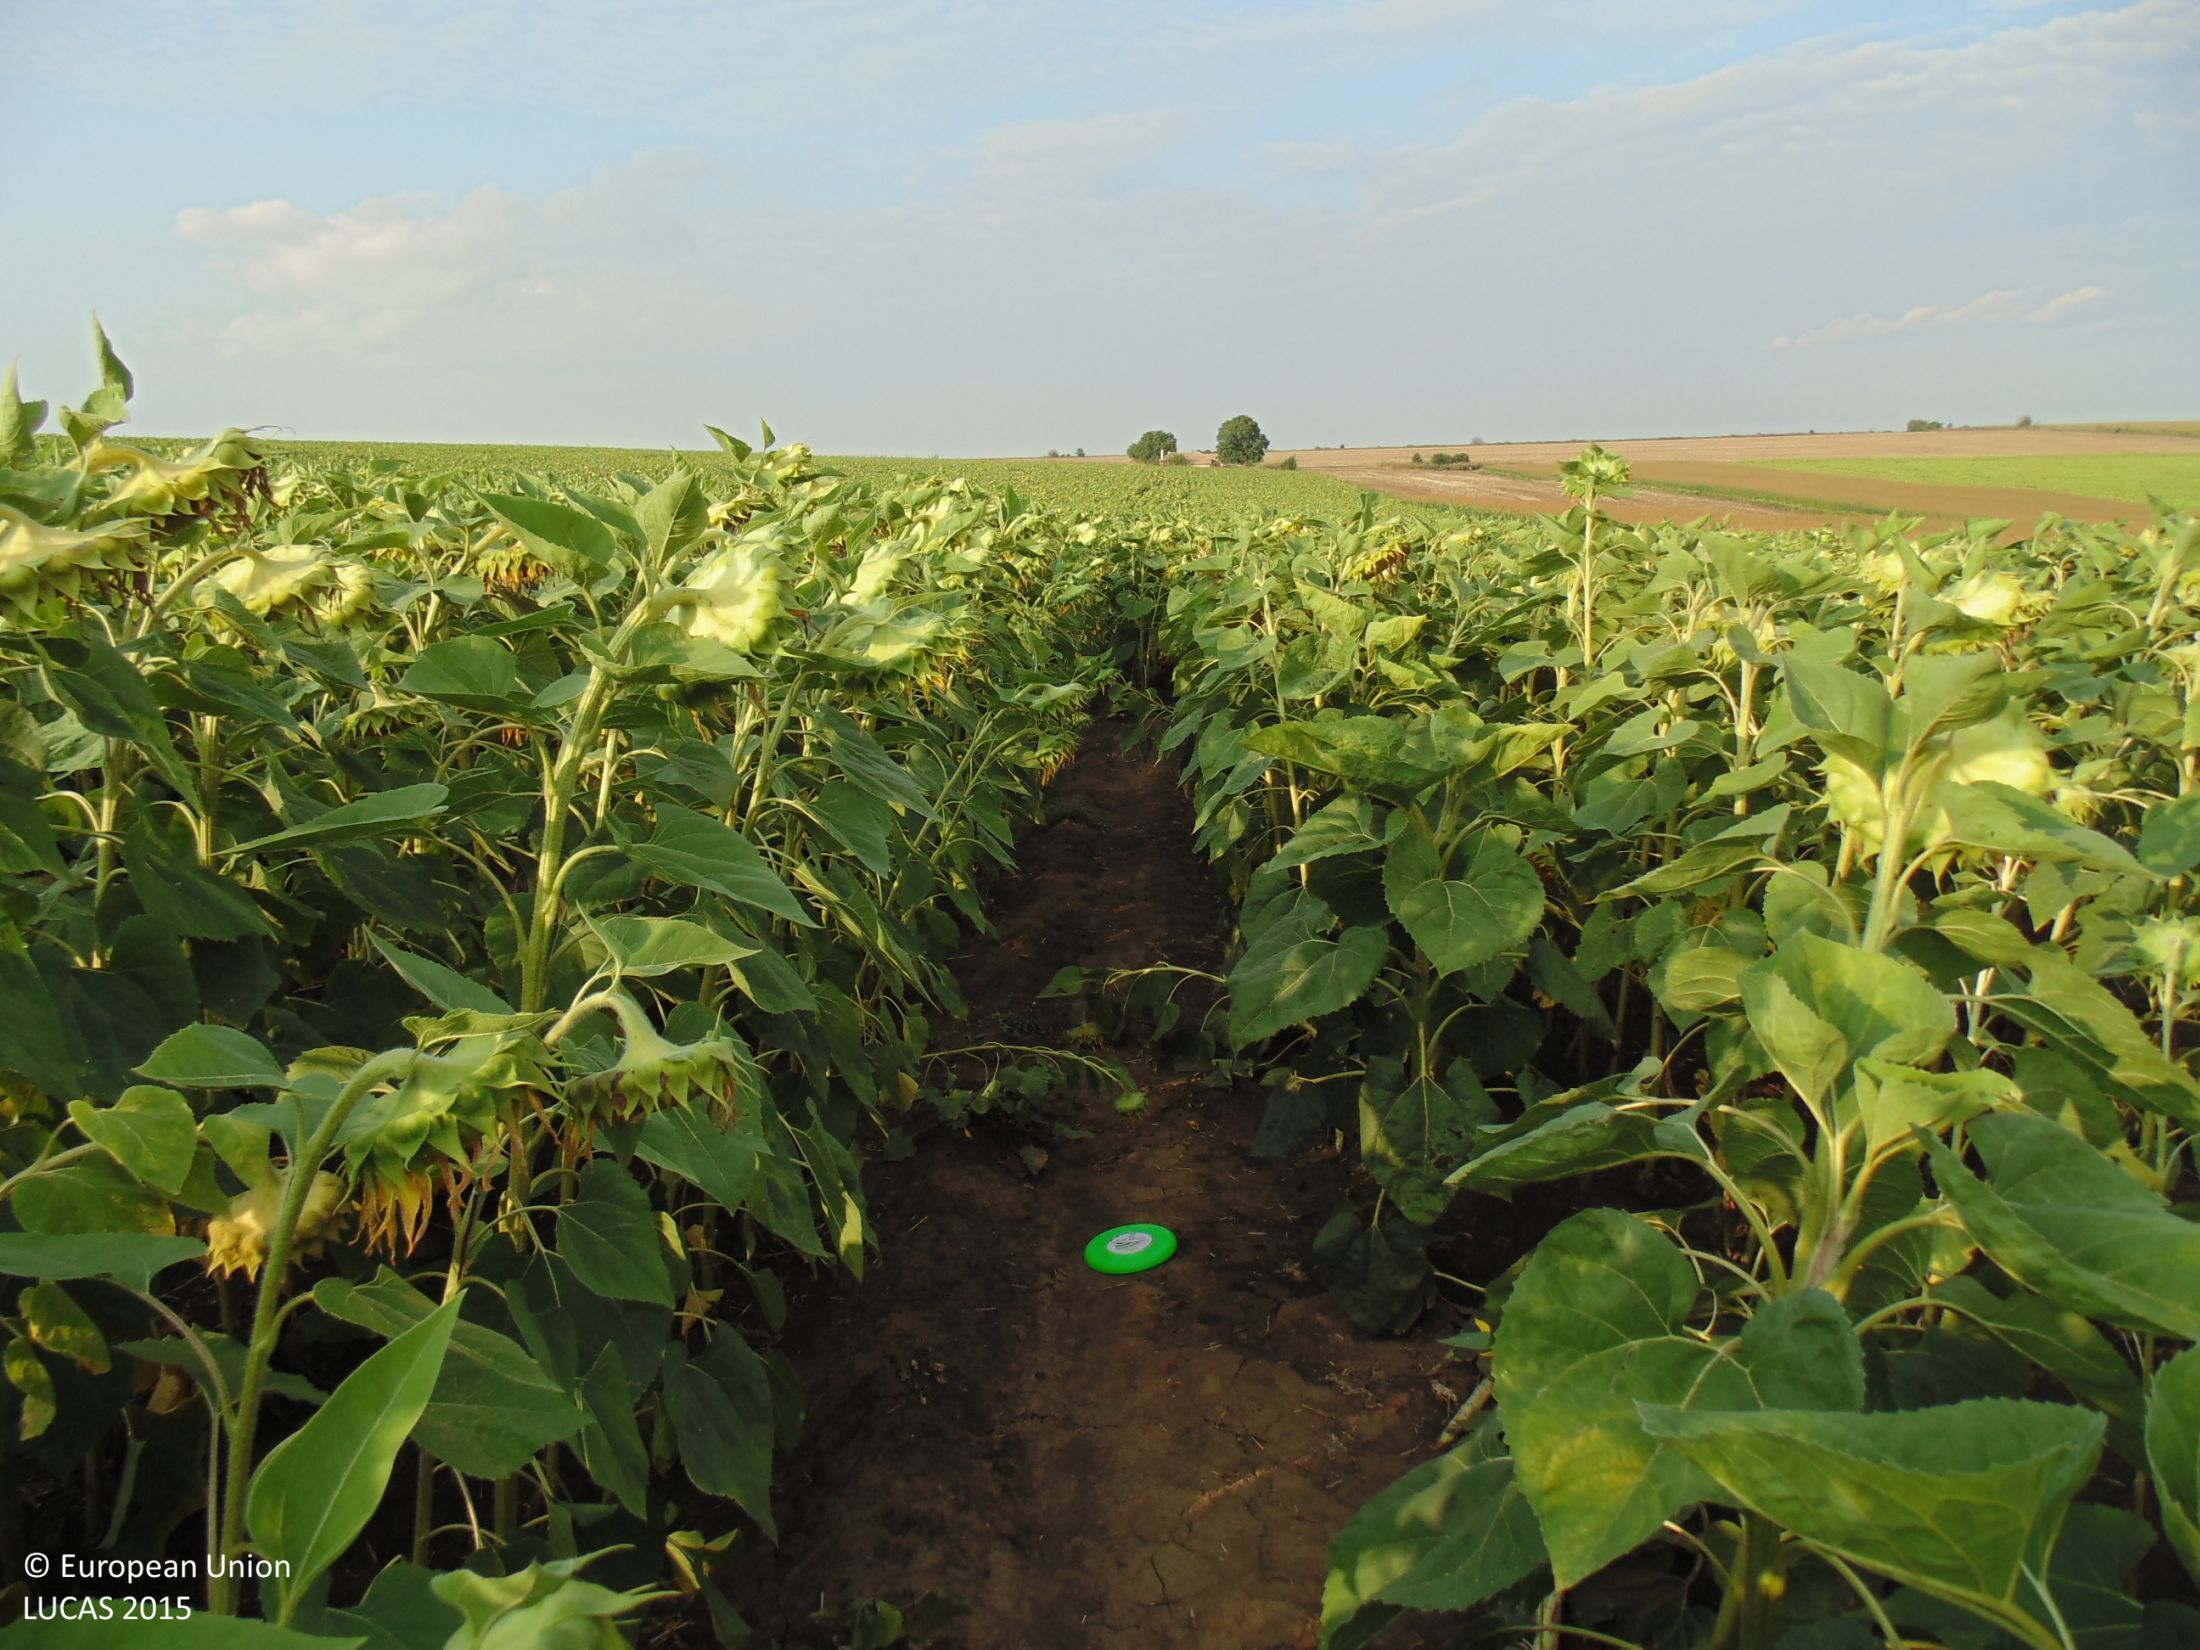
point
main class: Cropland
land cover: Sunflower
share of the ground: > 75 %
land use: Agriculture (excluding fallow land and kitchen gardens)
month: August
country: BG
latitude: 43.7617
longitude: 28.0751
